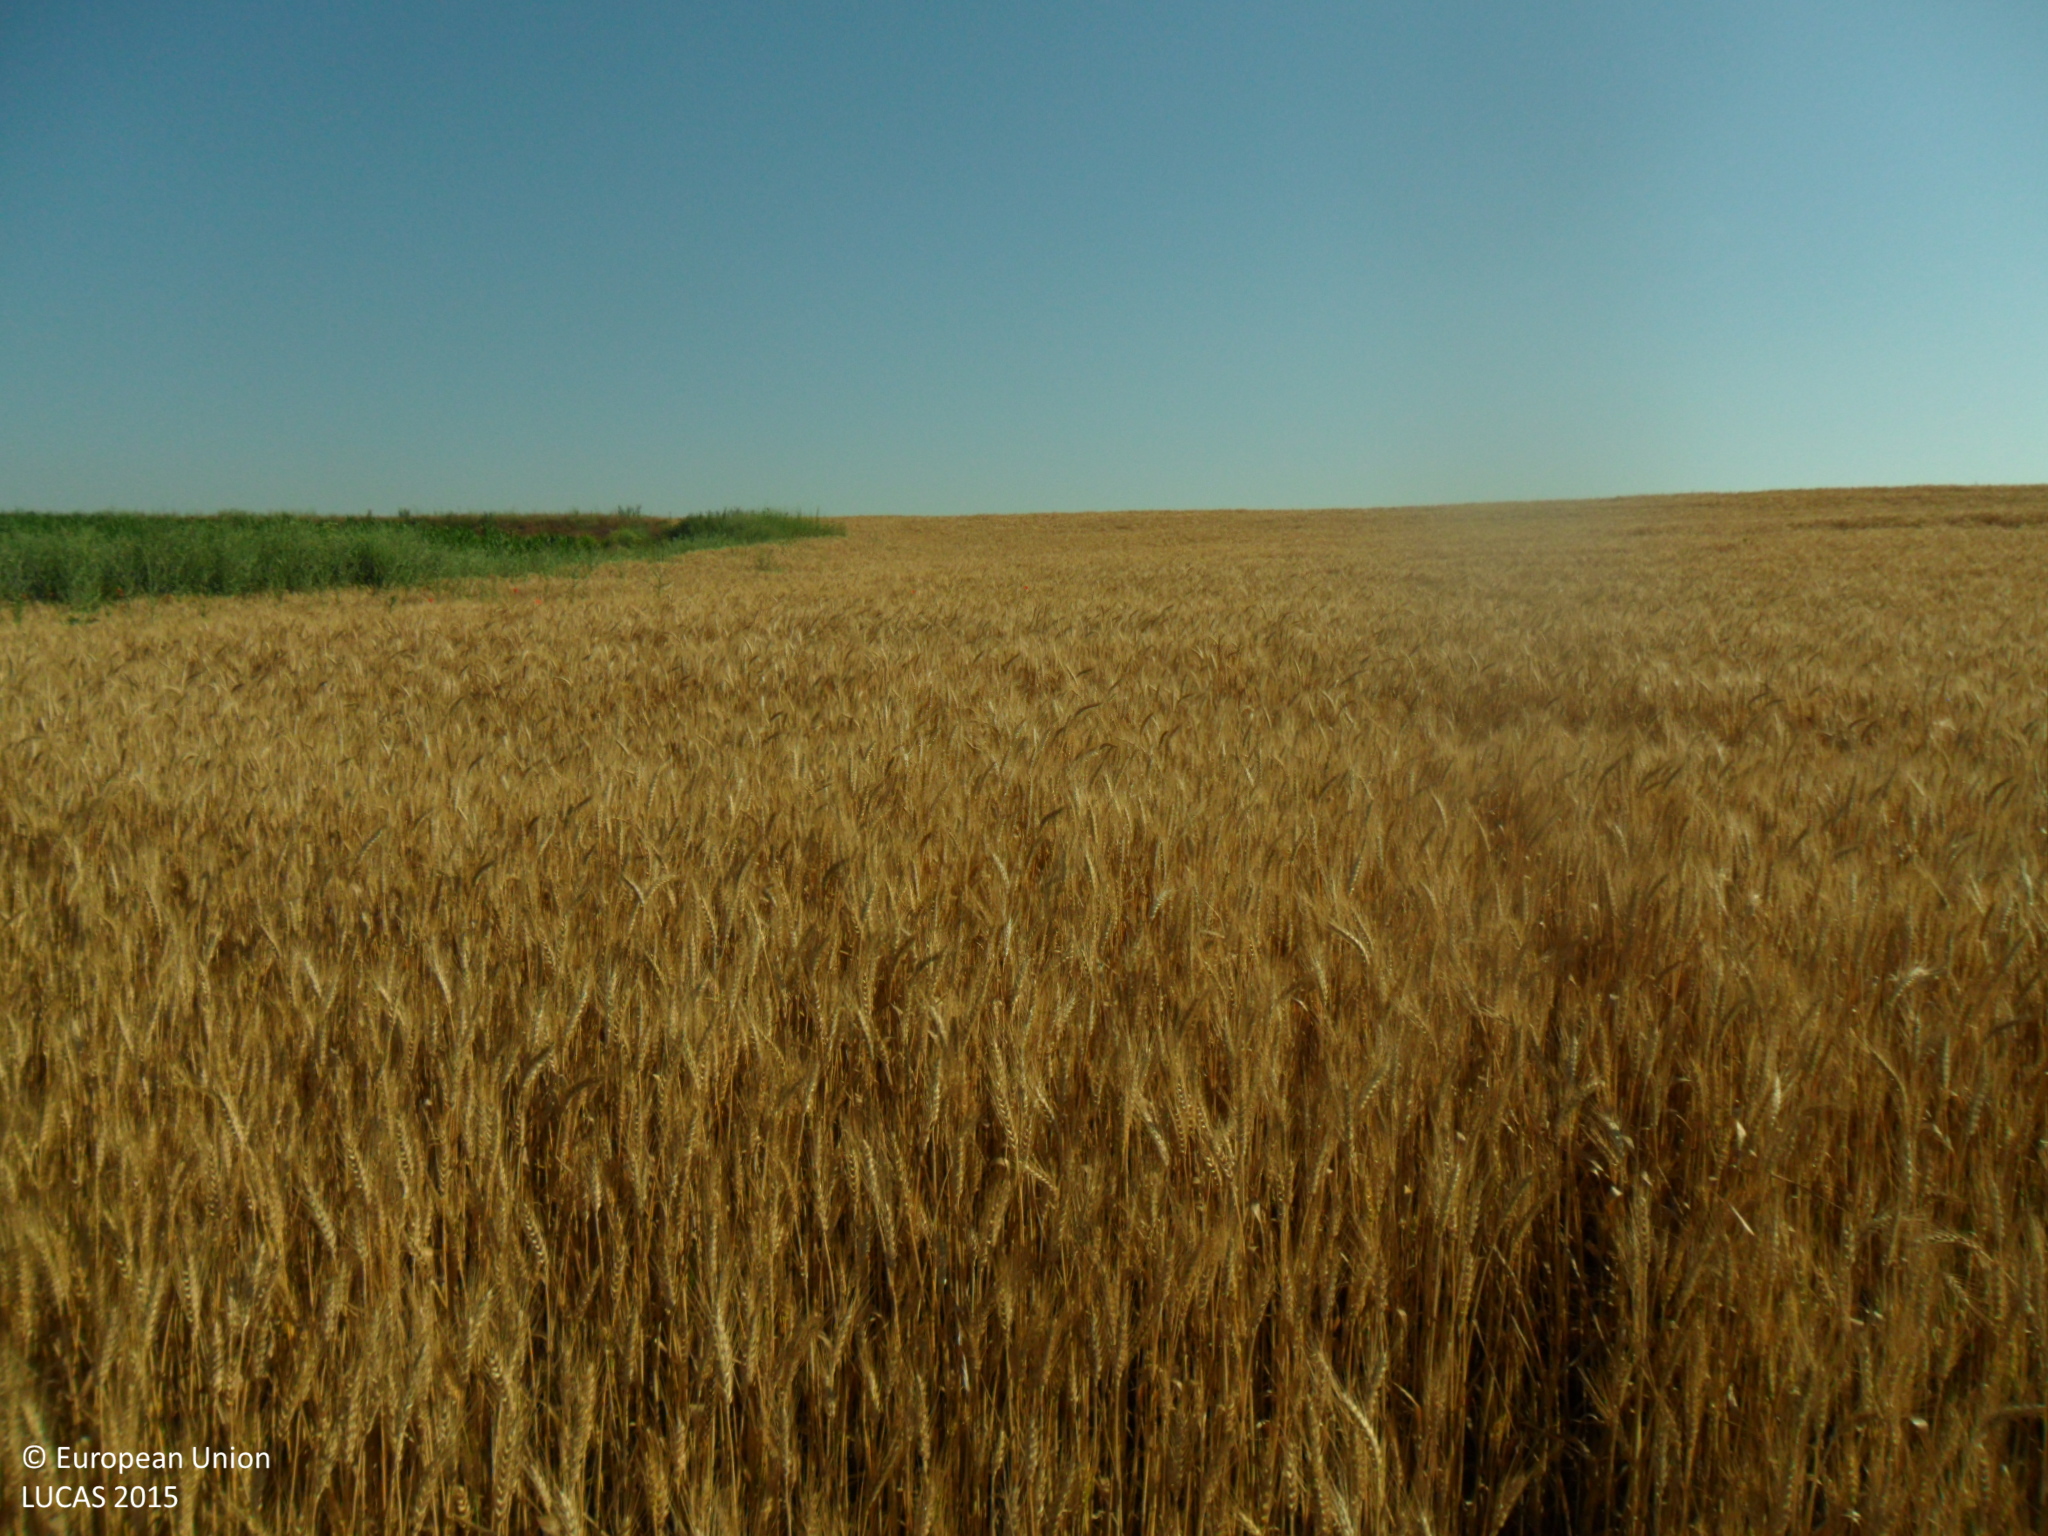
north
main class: Cropland
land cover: Common wheat
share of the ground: > 75 %
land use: Agriculture (excluding fallow land and kitchen gardens)
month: June
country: BG
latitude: 43.3275
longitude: 27.0743
